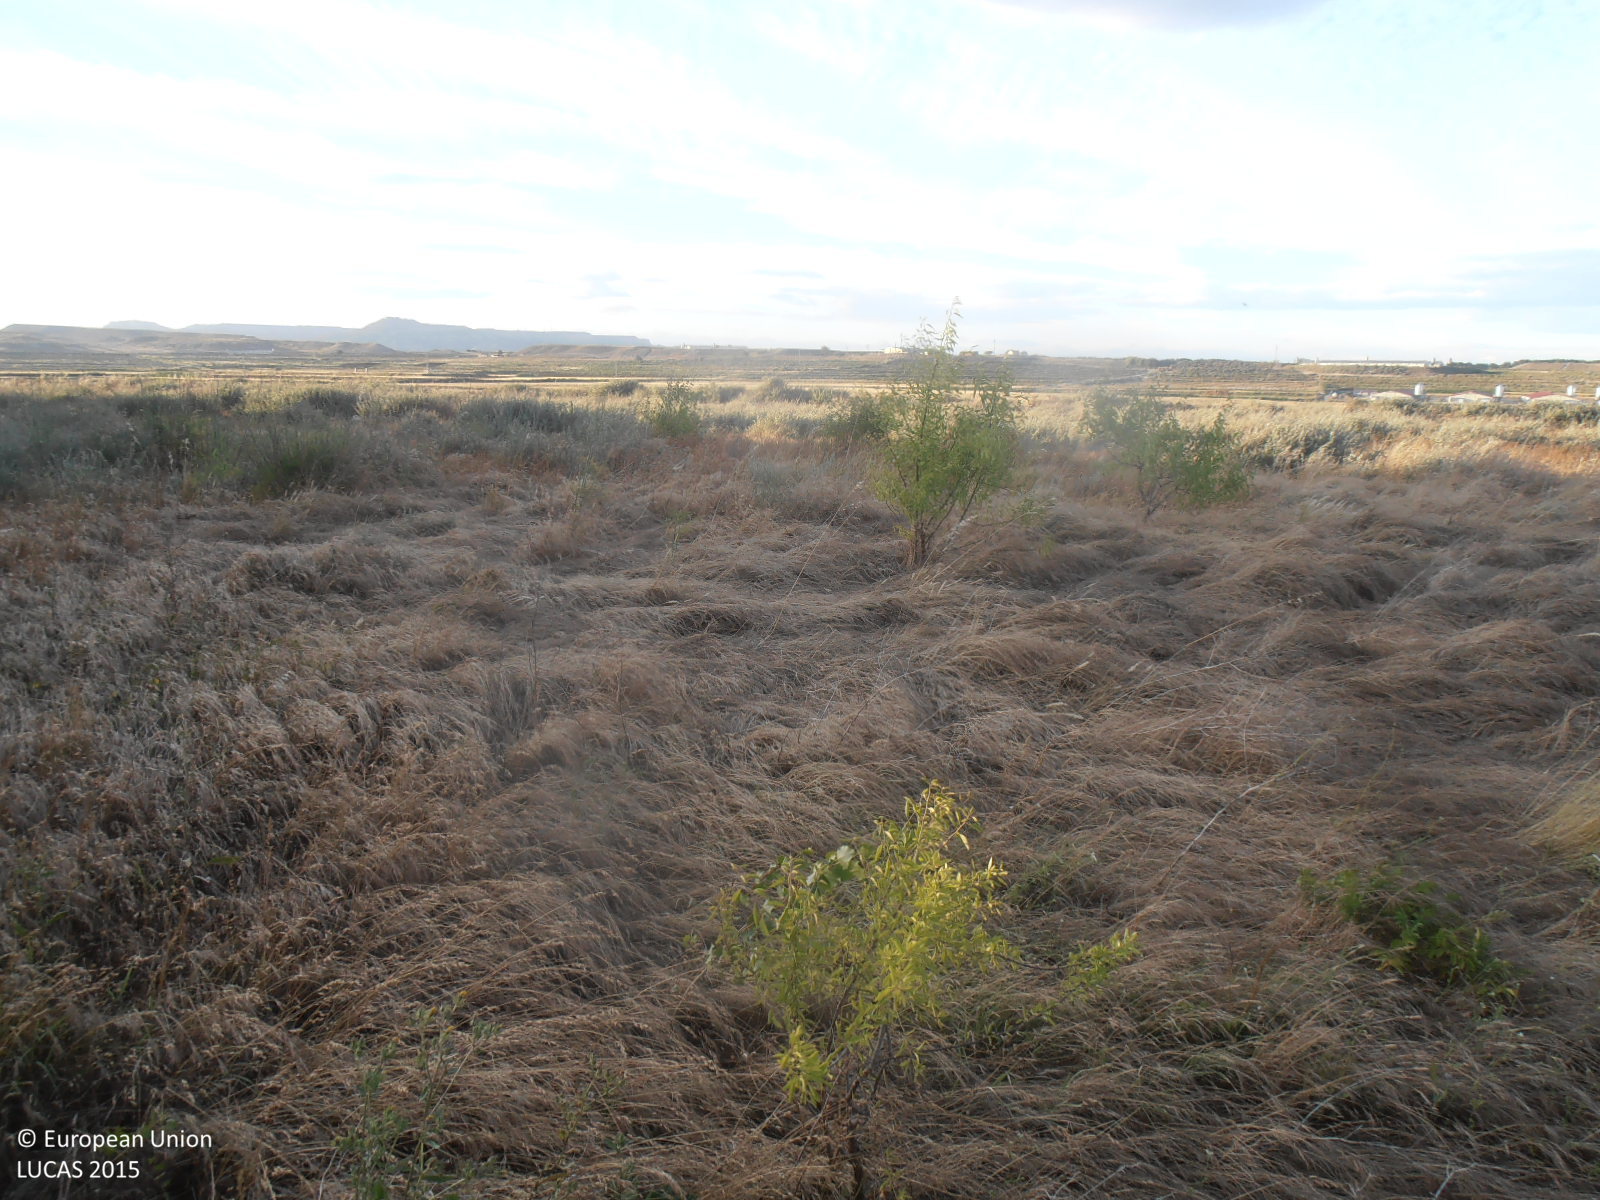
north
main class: Grassland
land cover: Grassland without tree/shrub cover
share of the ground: > 75 %
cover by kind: herbaceous plants 100 %
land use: Abandoned areas
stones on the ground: < 10 %
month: June
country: ES
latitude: 41.9460
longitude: -1.3065
